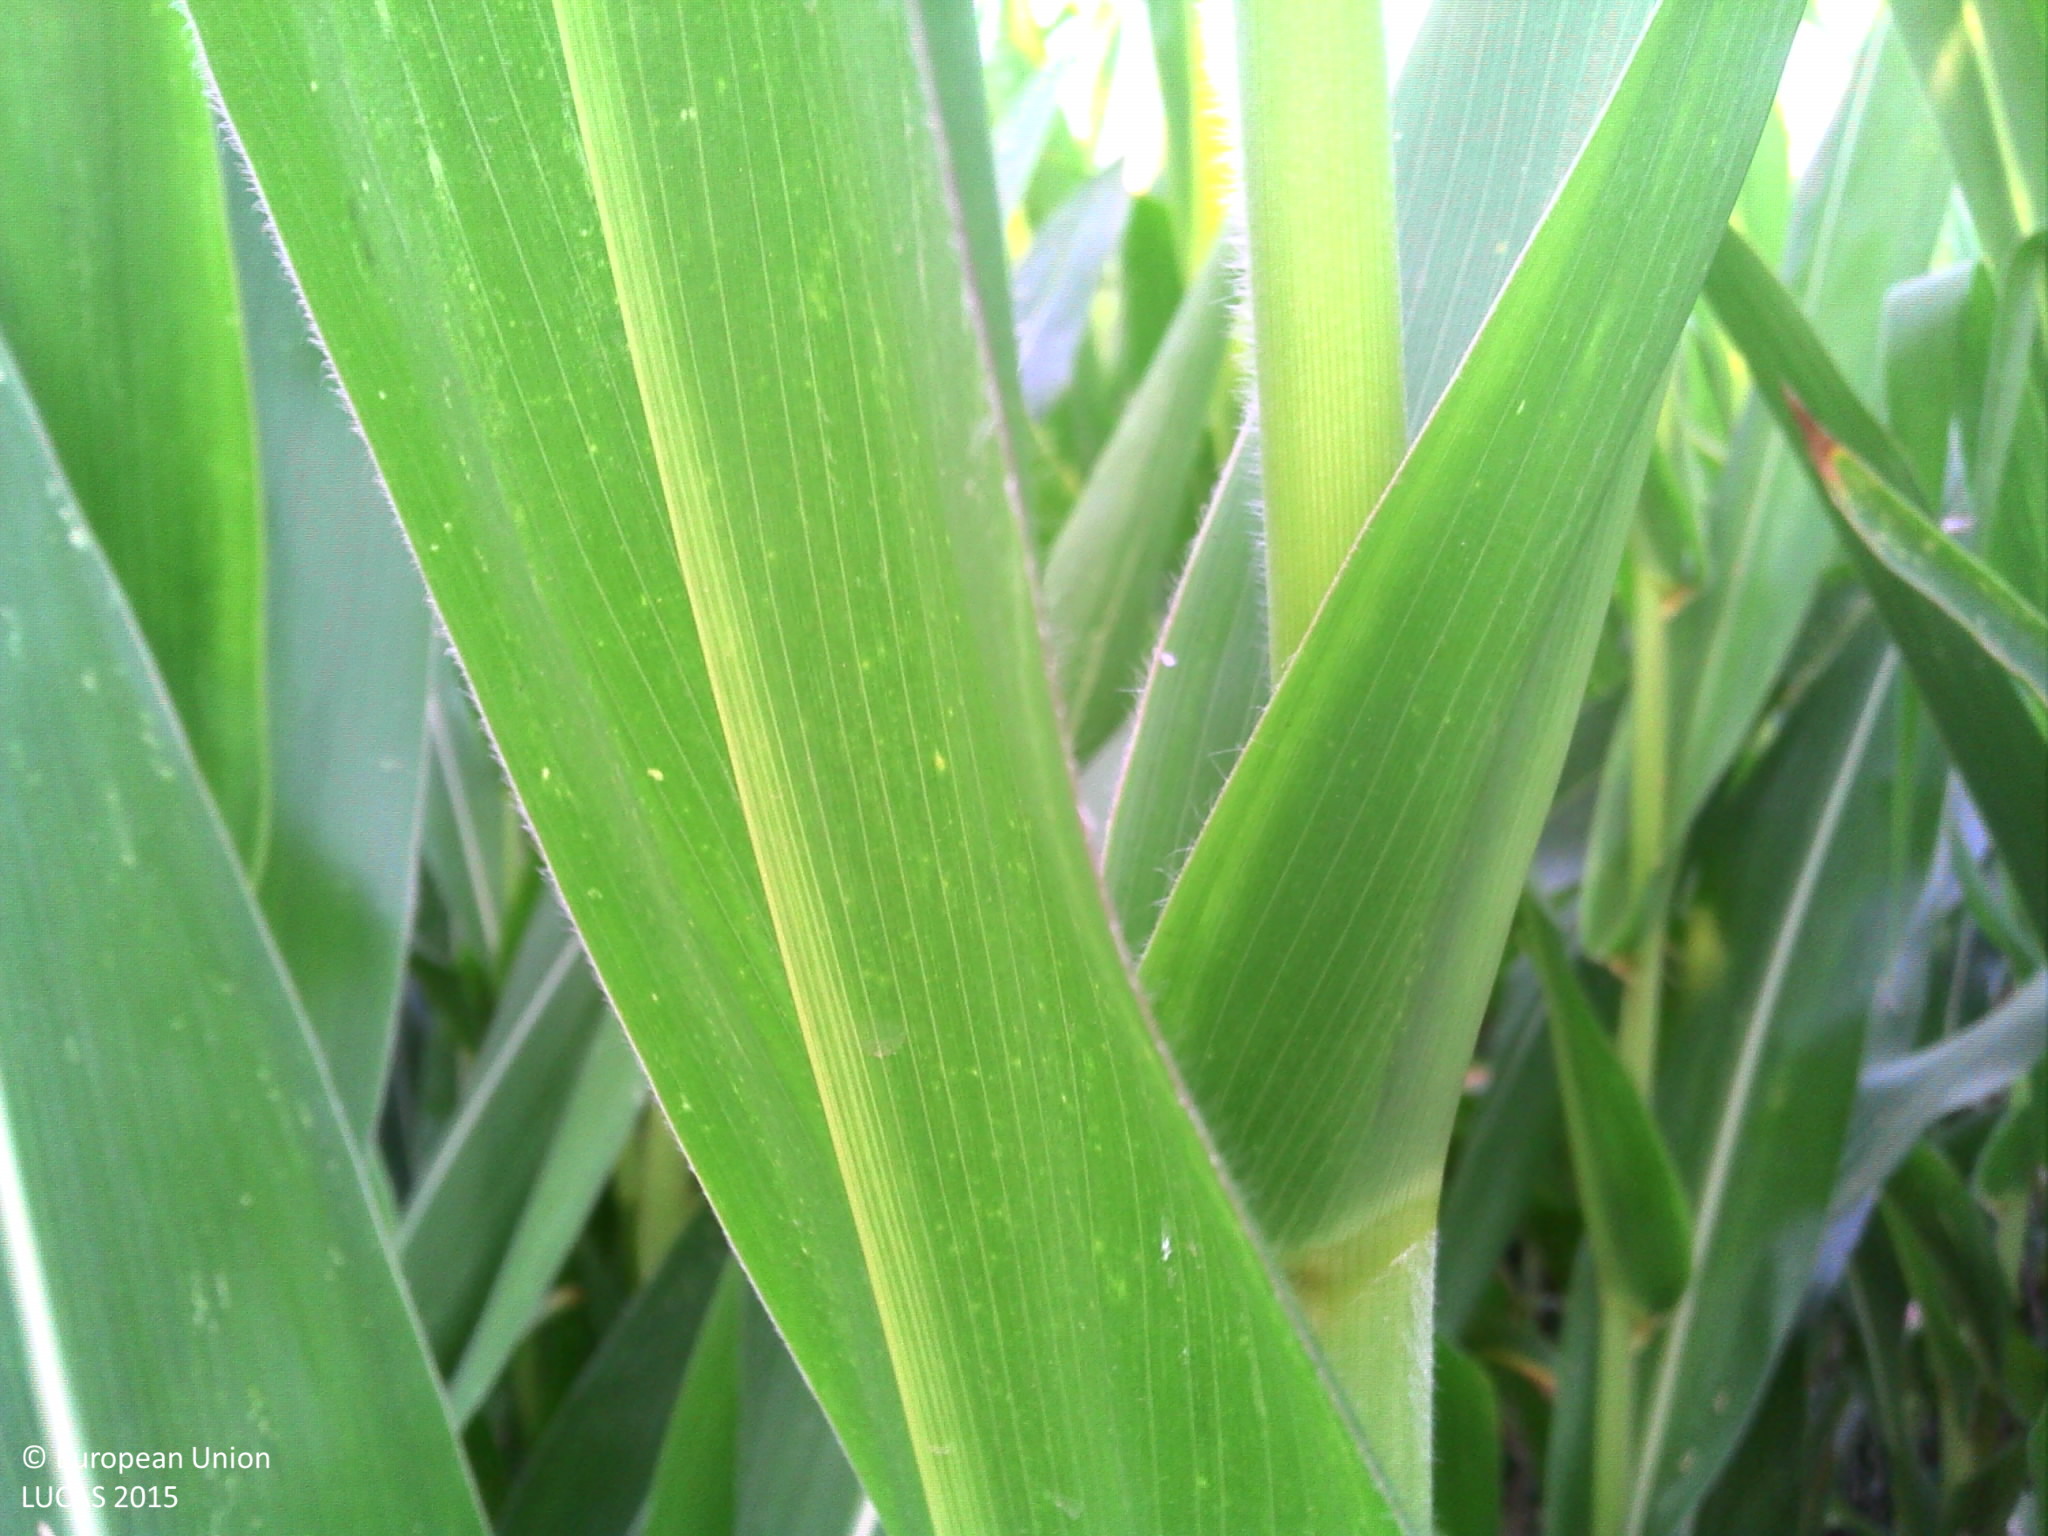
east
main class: Cropland
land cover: Maize
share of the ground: > 75 %
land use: Agriculture (excluding fallow land and kitchen gardens)
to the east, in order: Maize; Spontaneously vegetated surfaces; Fences; Electric lines; Grass margins; Paved roads, cycling and walking lanes; Grass margins; Ditches and canals; Grass margins; Fences; Grassland without tree/shrub cover
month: August
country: FR
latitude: 43.3933
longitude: -1.0629
